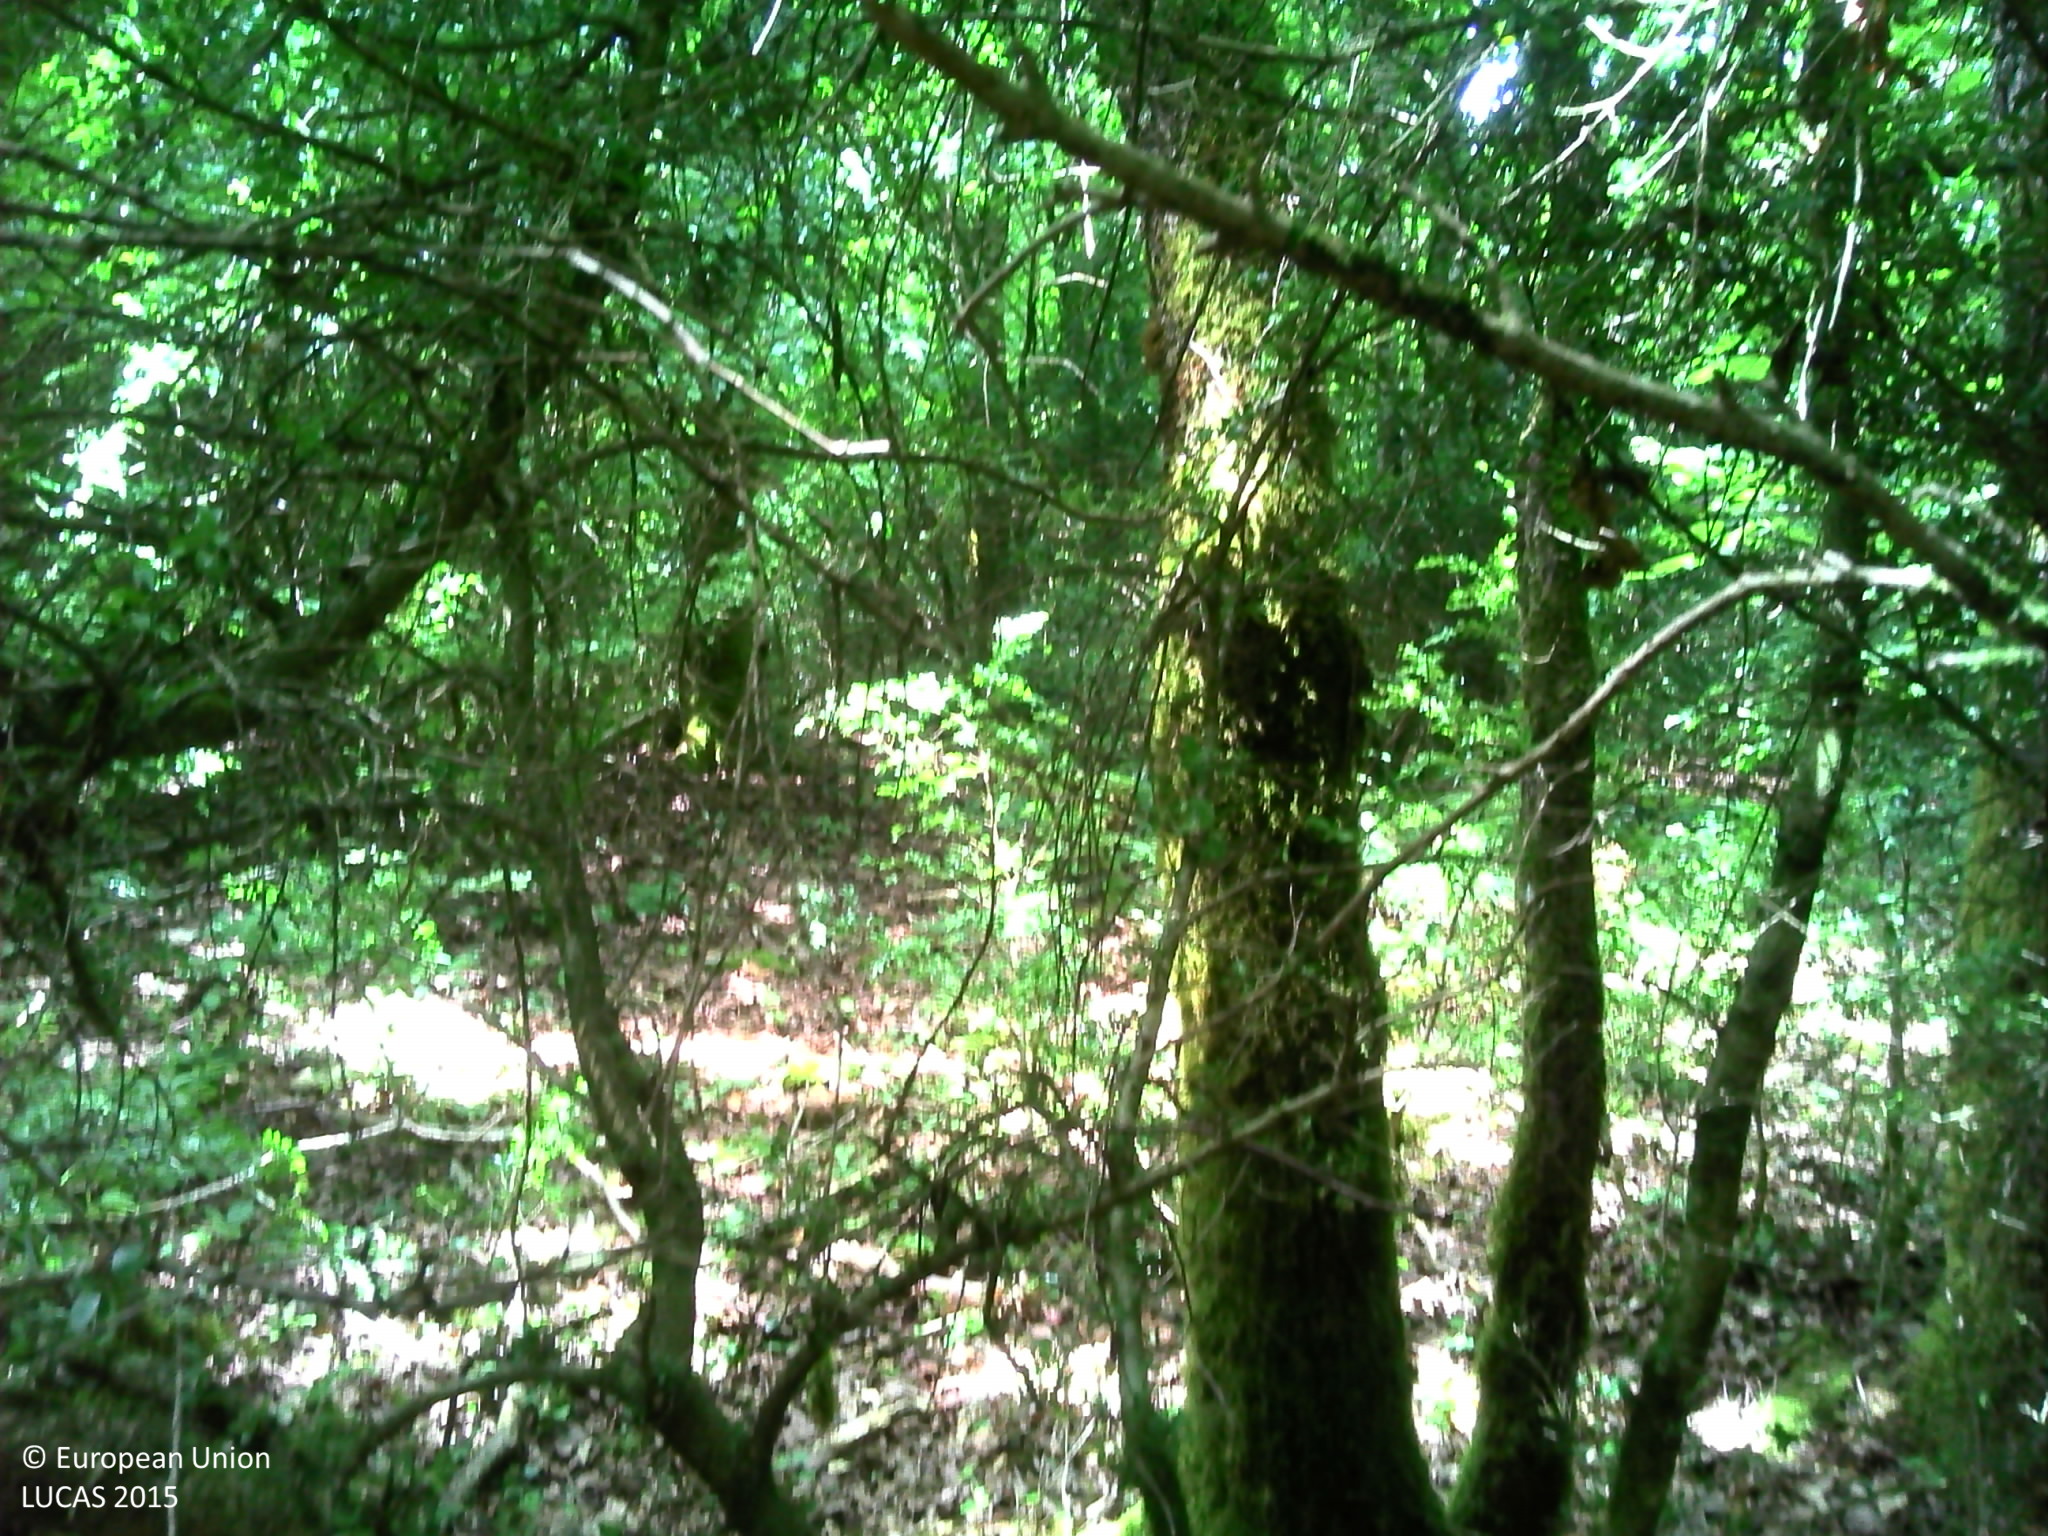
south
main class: Woodland
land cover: Broadleaved woodland
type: acidophilous oak and oak-birch forest
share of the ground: > 75 %
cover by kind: broadleaved forest trees 75 %, shrubs 10 %, herbaceous plants 10 %, lichens and mosses 5 %
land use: Agriculture (excluding fallow land and kitchen gardens)
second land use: Forestry
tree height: > 5 m
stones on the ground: > 50 %
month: June
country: FR
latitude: 46.4195
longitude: 5.5140
